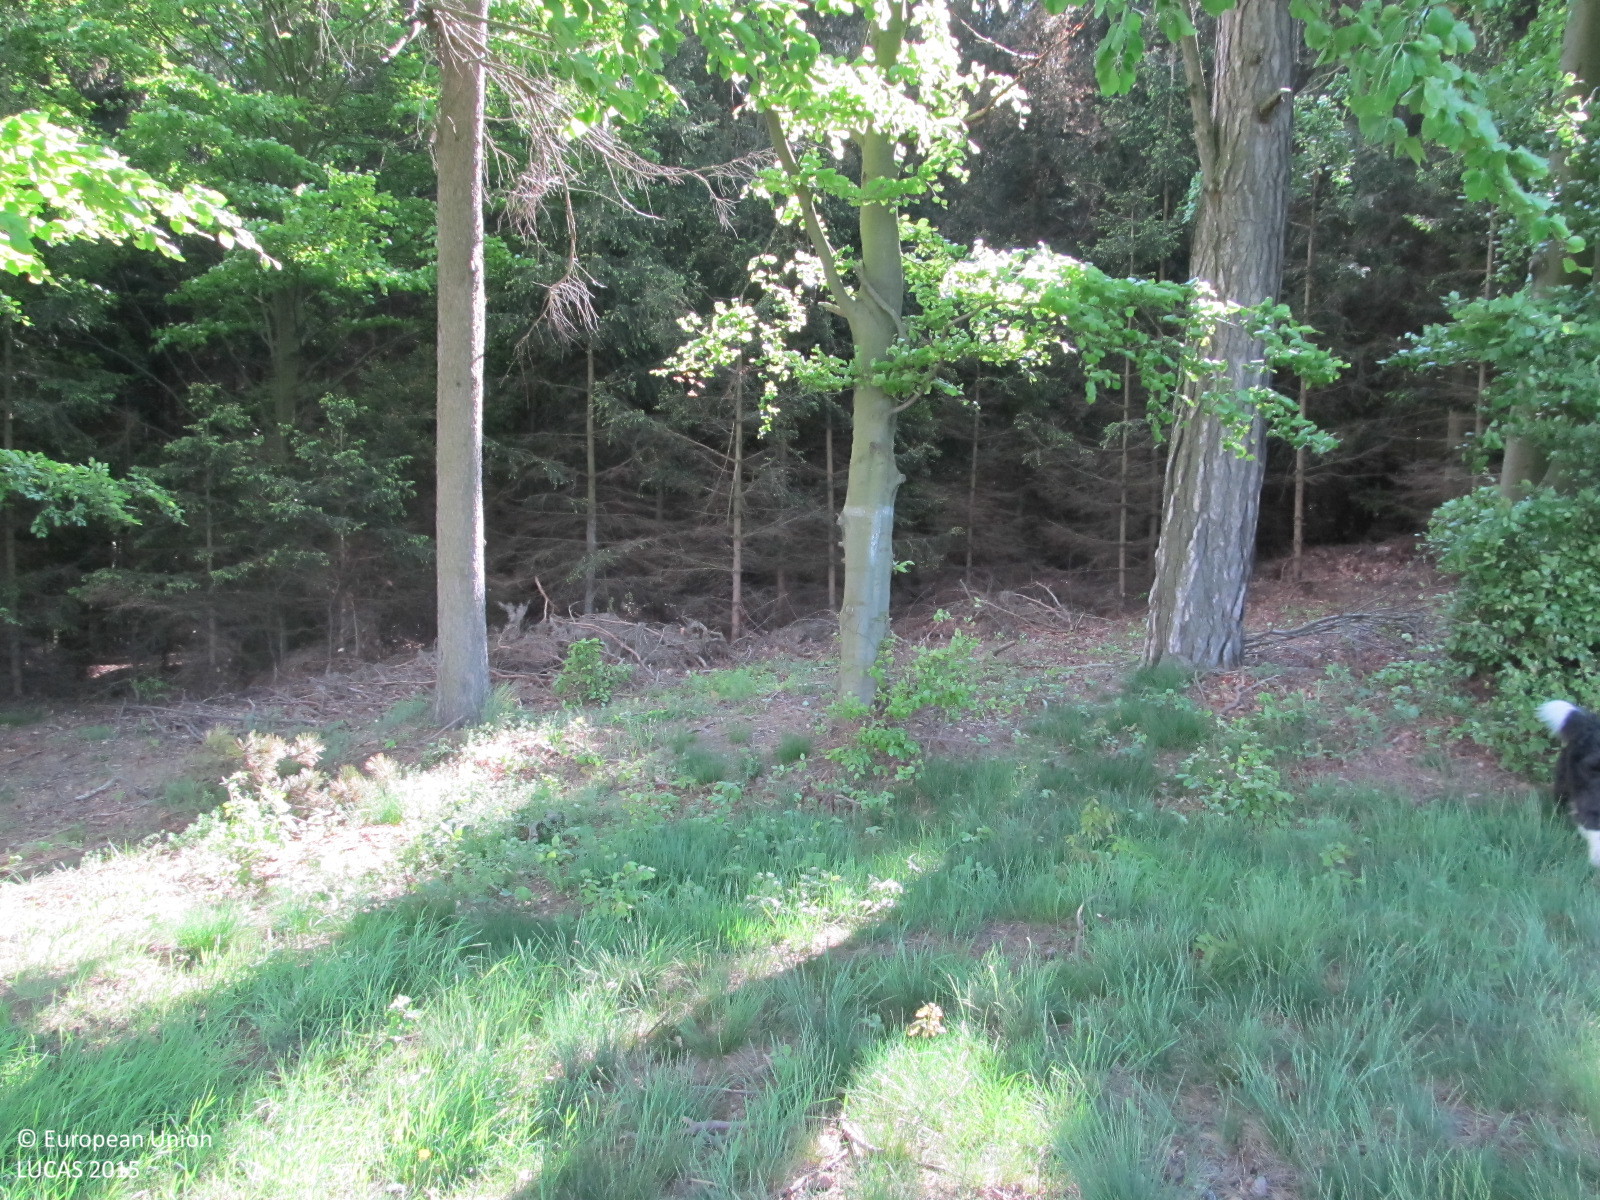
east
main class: Cropland
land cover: Common wheat
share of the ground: > 75 %
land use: Agriculture (excluding fallow land and kitchen gardens)
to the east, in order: Common wheat; Grass margins; Single bushes/trees; Spruce dominated coniferous woodland; Tracks; Spruce dominated coniferous woodland
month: May
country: AT
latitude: 48.5736
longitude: 15.4919
